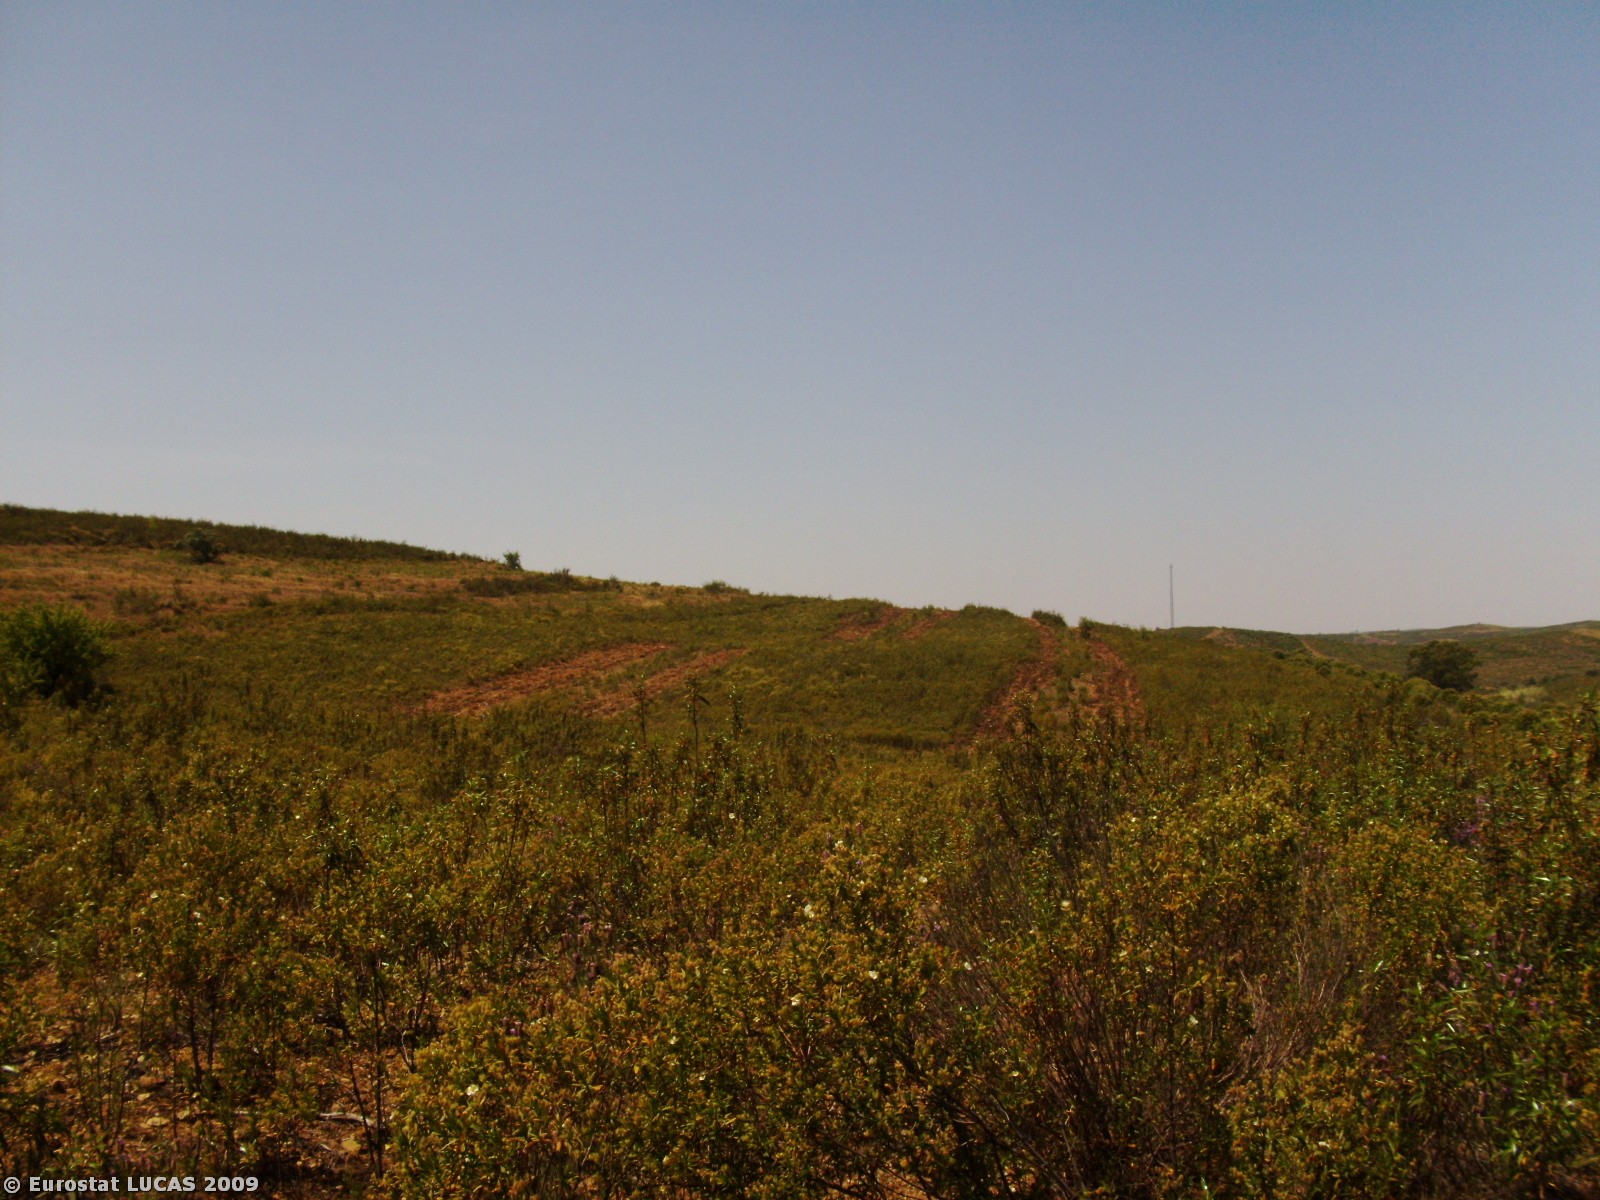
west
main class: Shrubland
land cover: Shrubland without tree cover
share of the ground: 50 - 75 %
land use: Unused
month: May
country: PT
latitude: 37.4356
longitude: -7.5379
